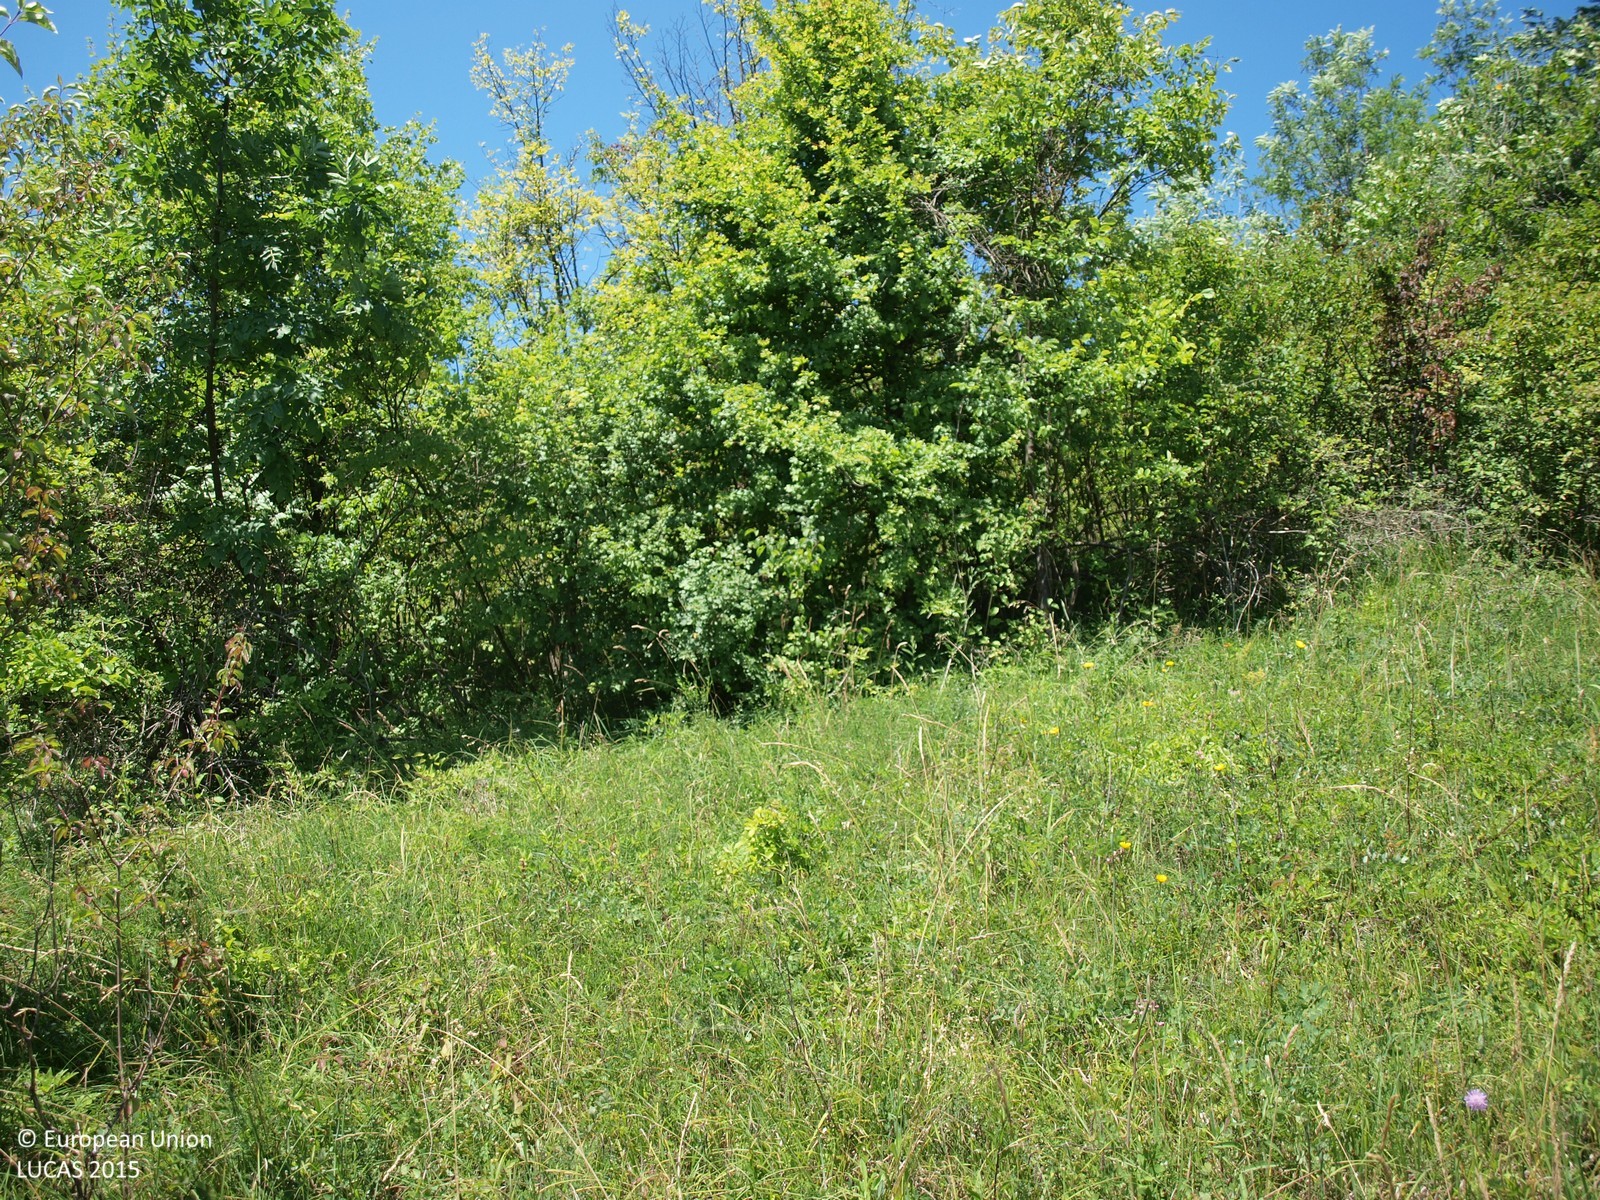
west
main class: Grassland
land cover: Grassland with sparse tree/shrub cover
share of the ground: > 75 %
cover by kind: herbaceous plants 95 %, broadleaved forest trees 5 %
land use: Agriculture (excluding fallow land and kitchen gardens)
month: July
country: HR
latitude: 45.9071
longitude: 15.7599
